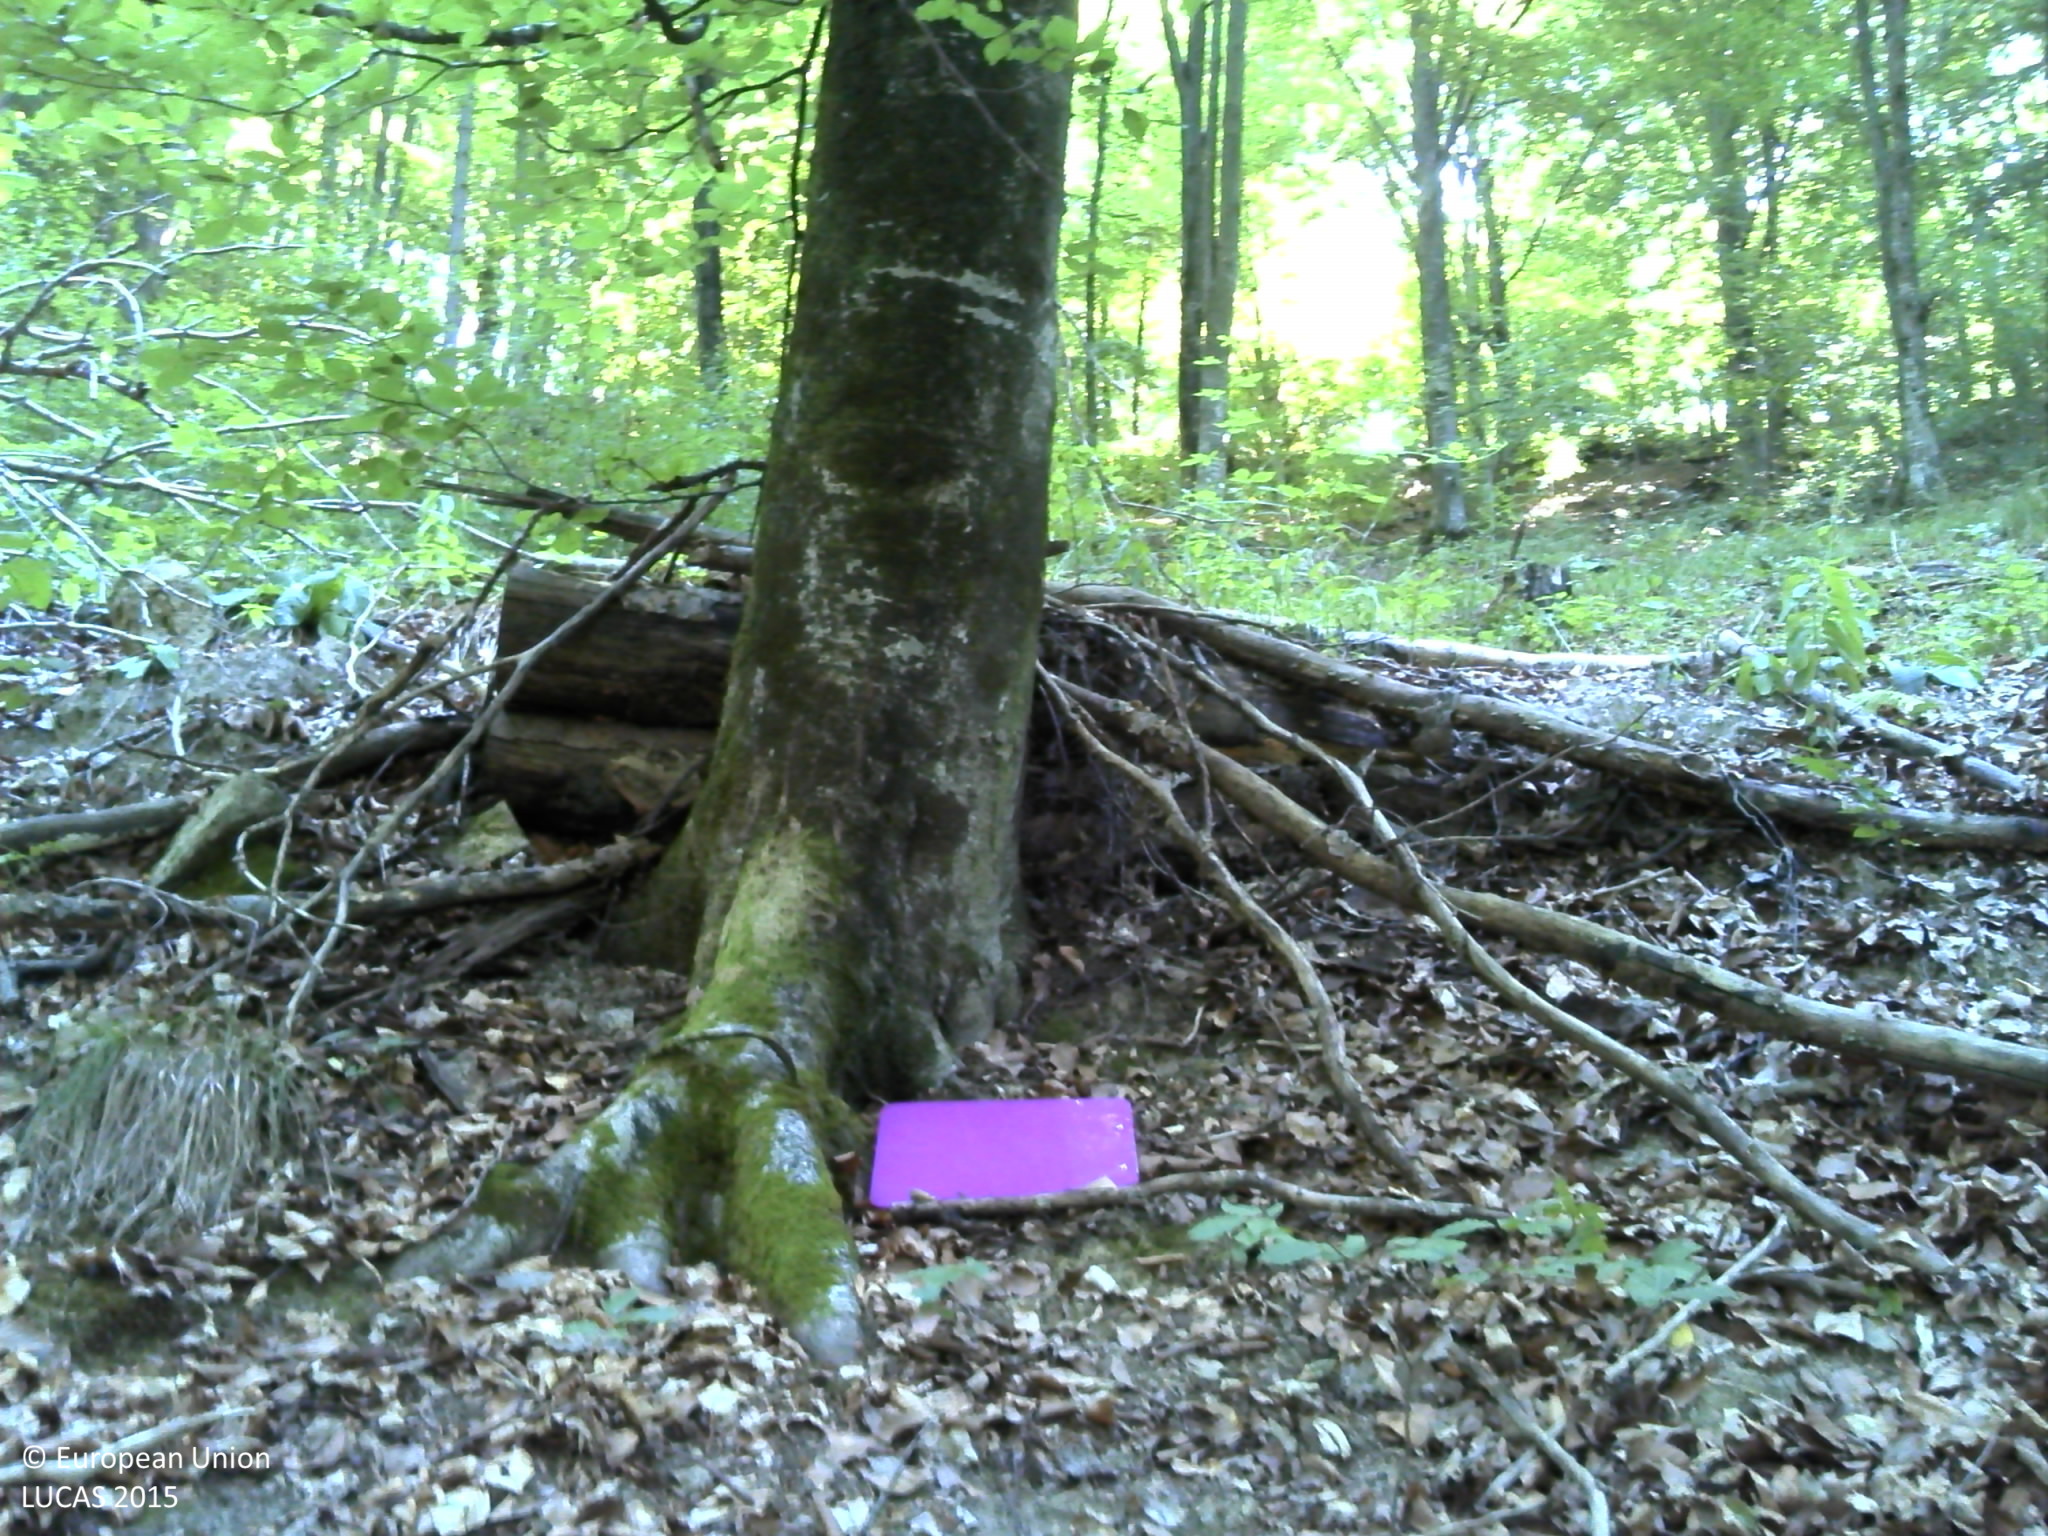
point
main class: Woodland
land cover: Broadleaved woodland
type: beech forest
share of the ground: > 75 %
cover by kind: broadleaved forest trees 100 %
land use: Forestry
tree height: > 5 m
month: August
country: HR
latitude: 45.5544
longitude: 17.3669
